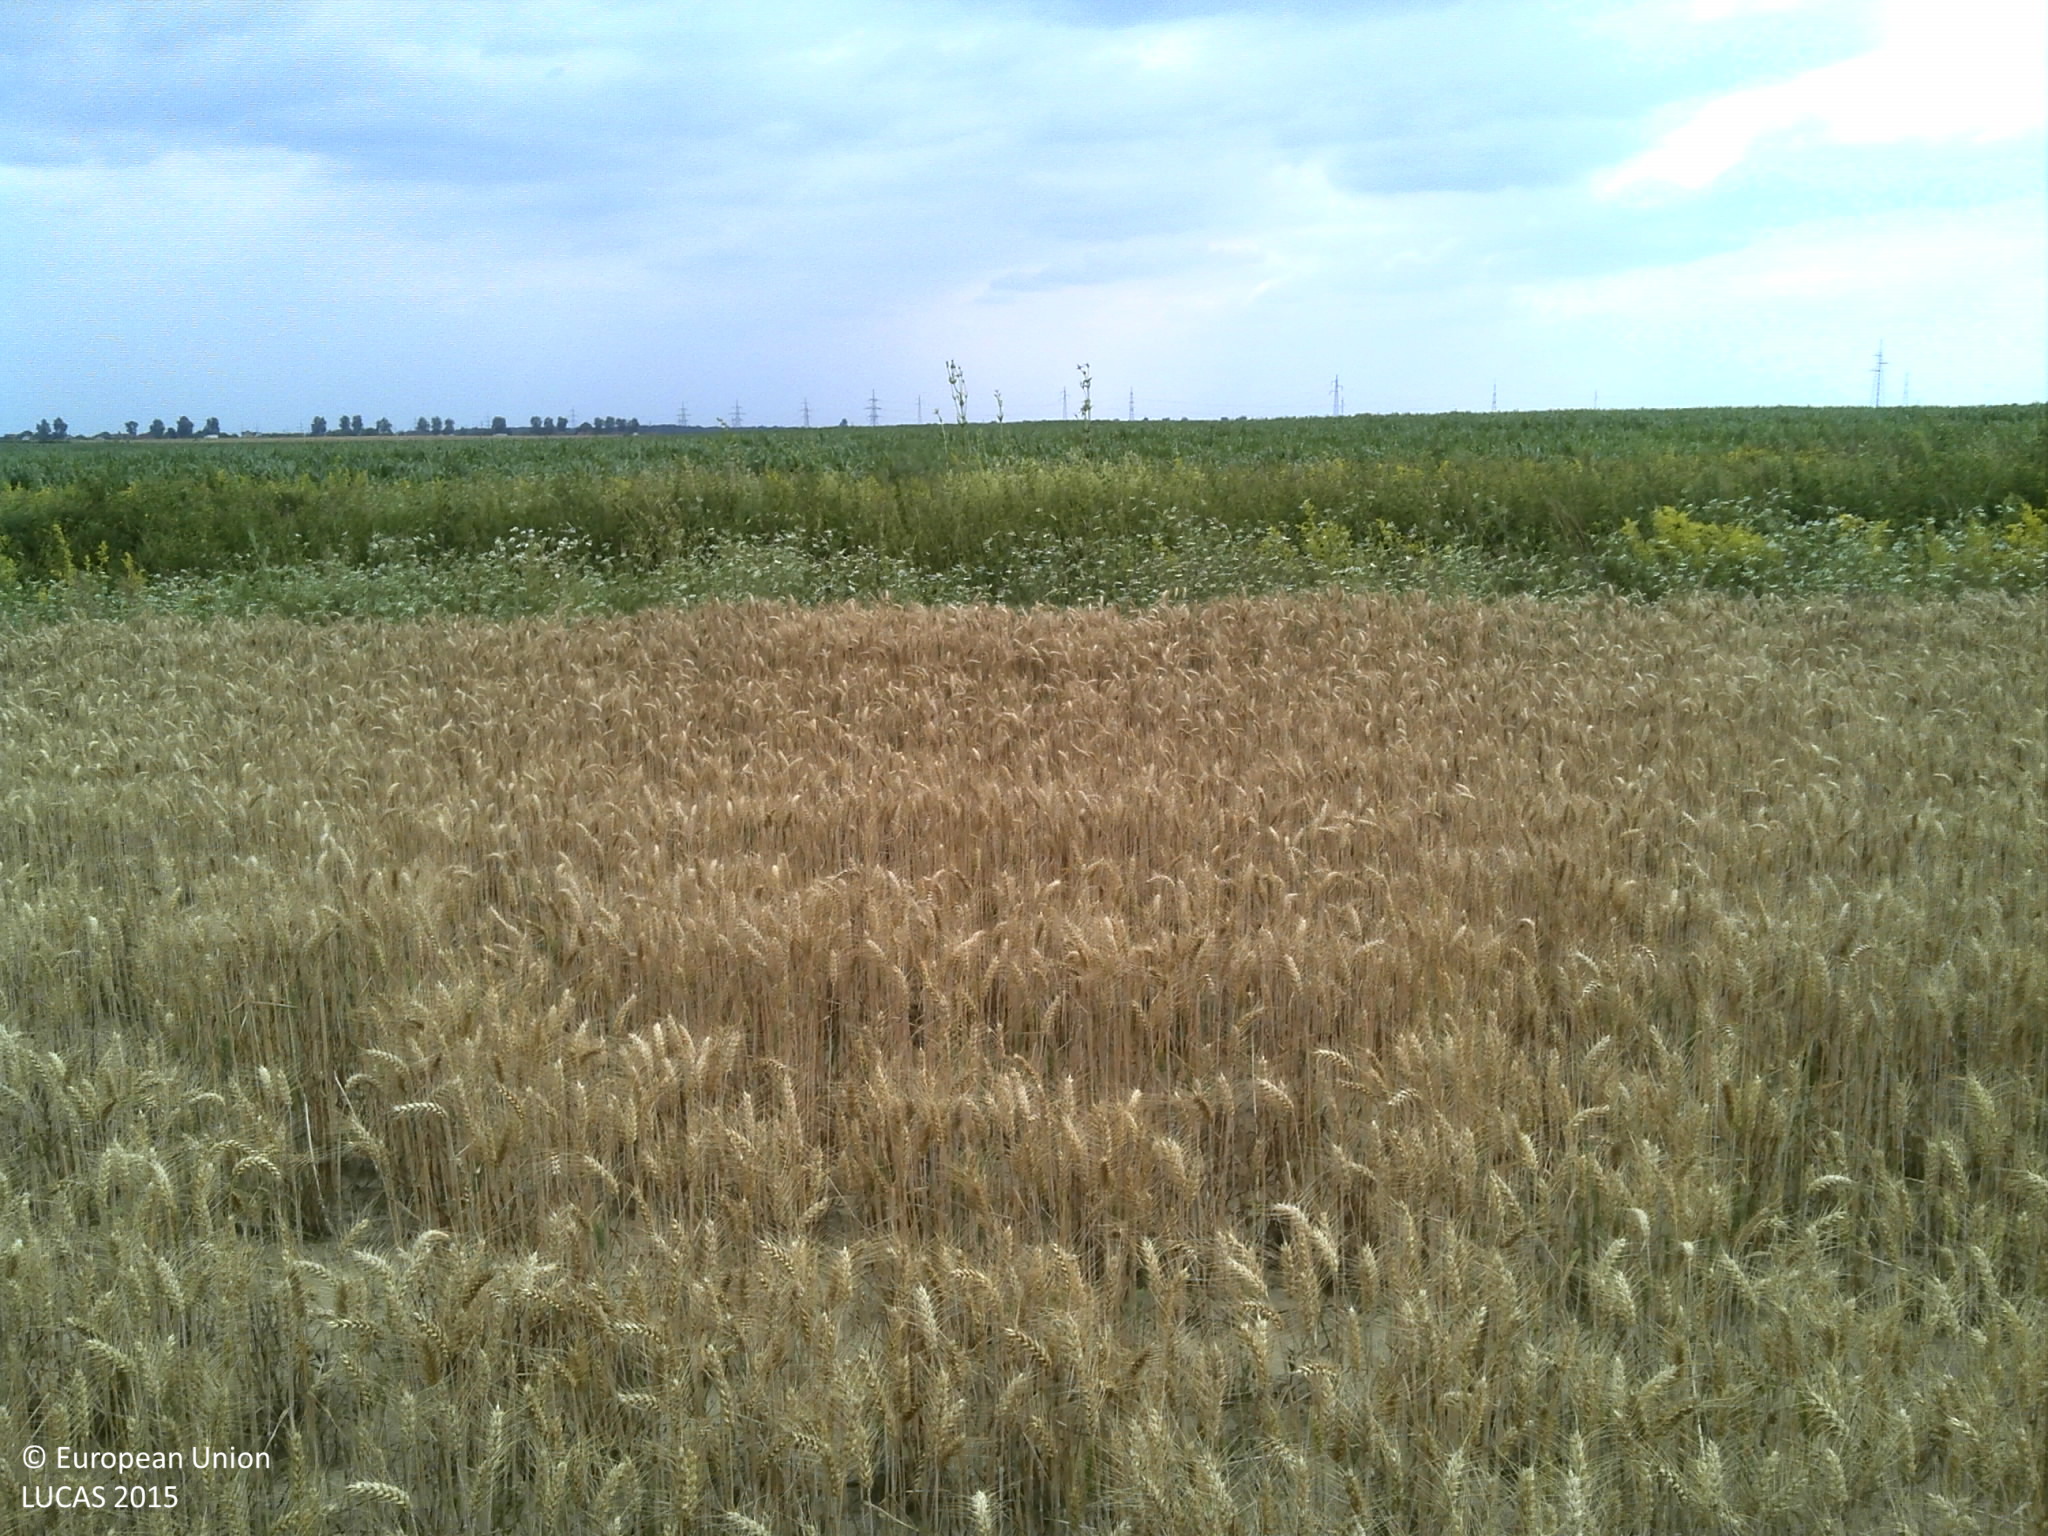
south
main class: Cropland
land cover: Barley
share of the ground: > 75 %
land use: Agriculture (excluding fallow land and kitchen gardens)
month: June
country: HR
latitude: 45.5514
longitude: 18.6022
